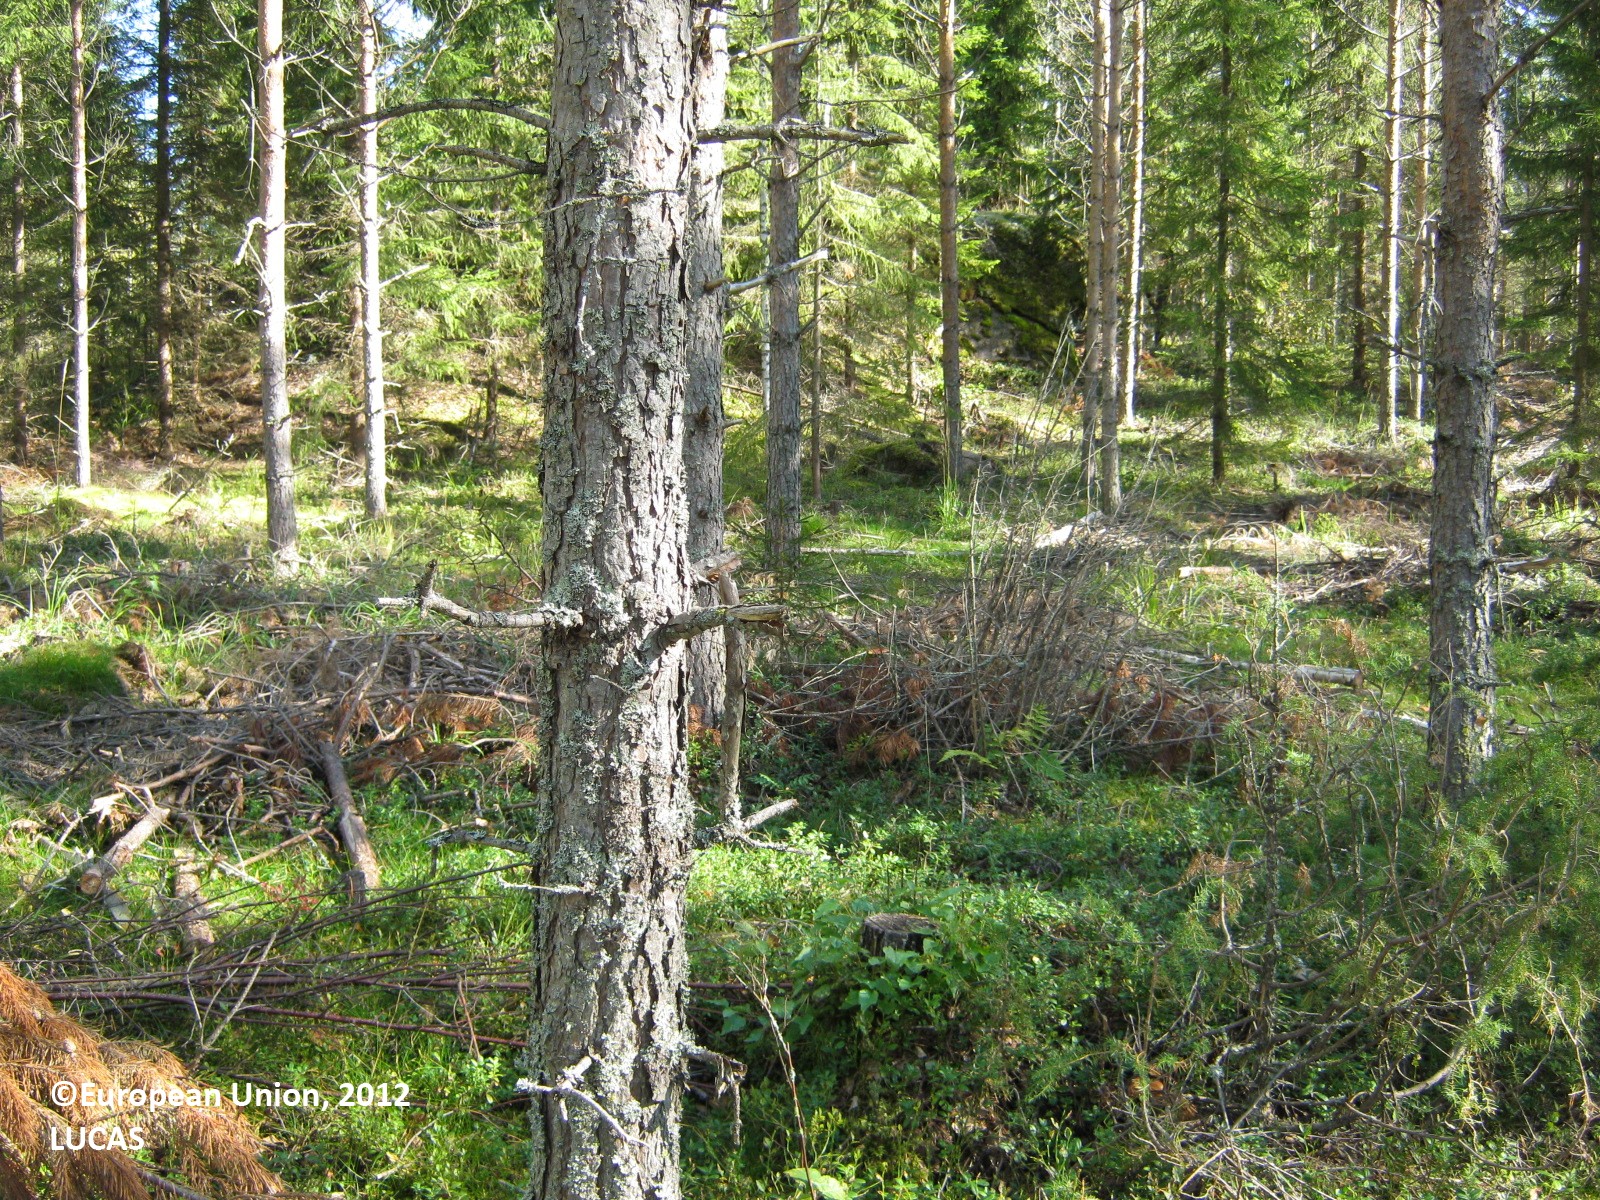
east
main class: Woodland
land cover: Pine dominated coniferous woodland
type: boreal forest
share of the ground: > 75 %
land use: Forestry
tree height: > 5 m
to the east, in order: Pine dominated coniferous woodland; Other coniferous woodland; Pine dominated coniferous woodland; Broadleaved woodland
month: September
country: FI
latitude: 60.9535
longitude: 27.8647
